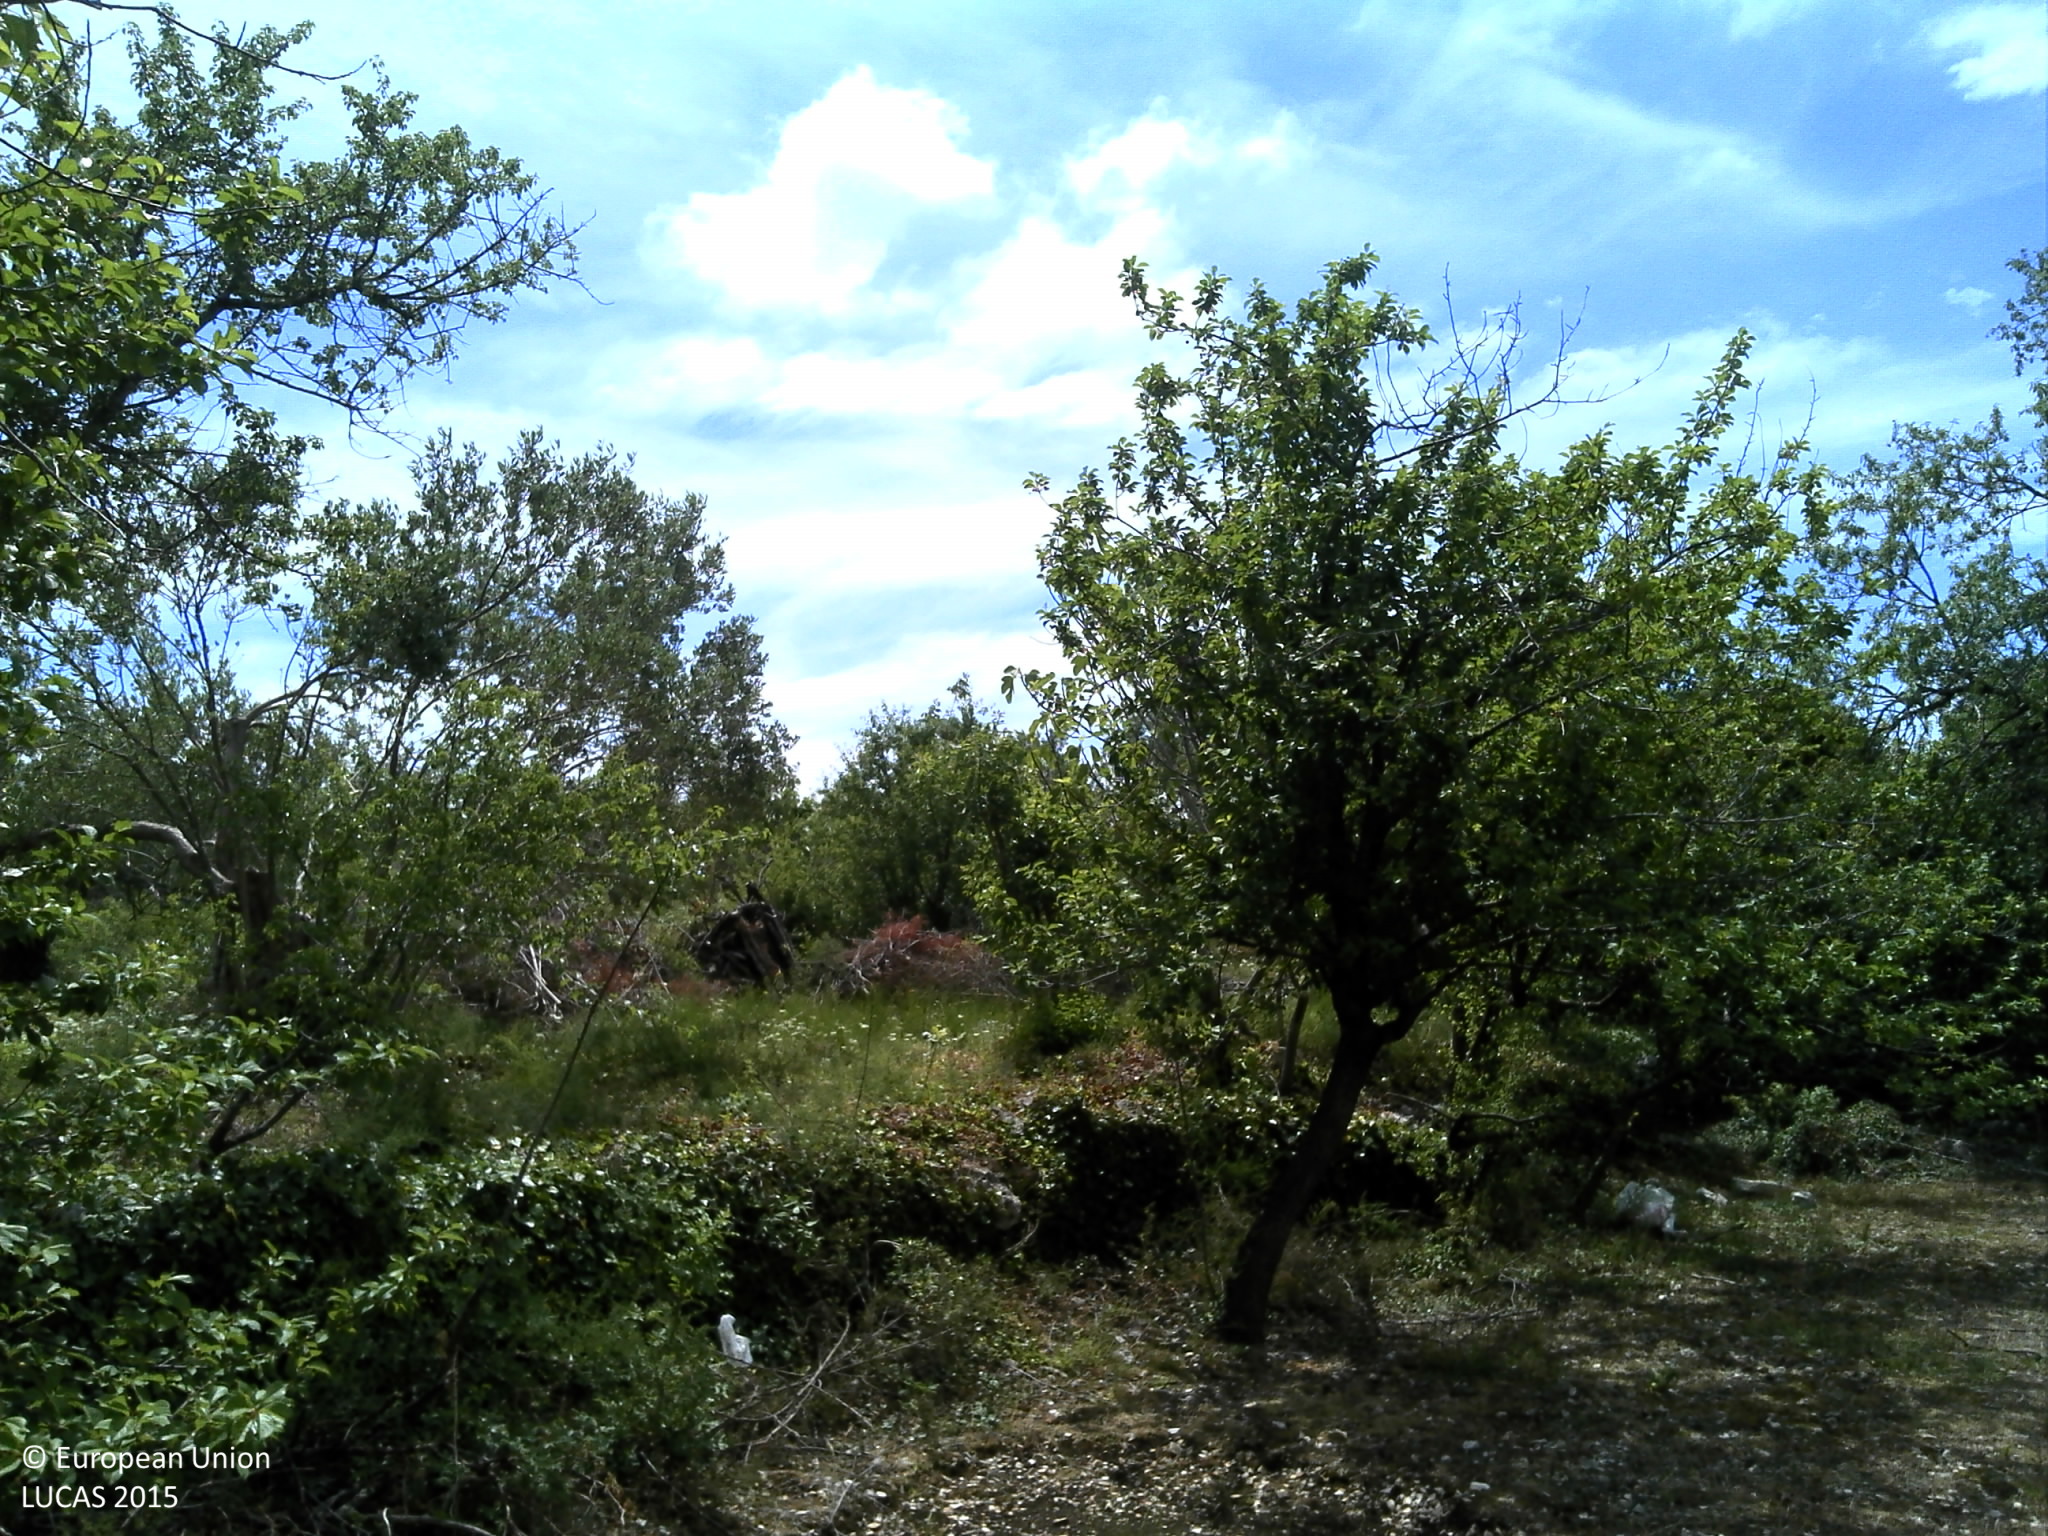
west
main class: Cropland
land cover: Cherry fruit
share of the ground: < 10 %
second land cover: Grassland without tree/shrub cover
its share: > 75 %
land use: Agriculture (excluding fallow land and kitchen gardens)
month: May
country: HR
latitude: 43.5788
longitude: 16.0214
